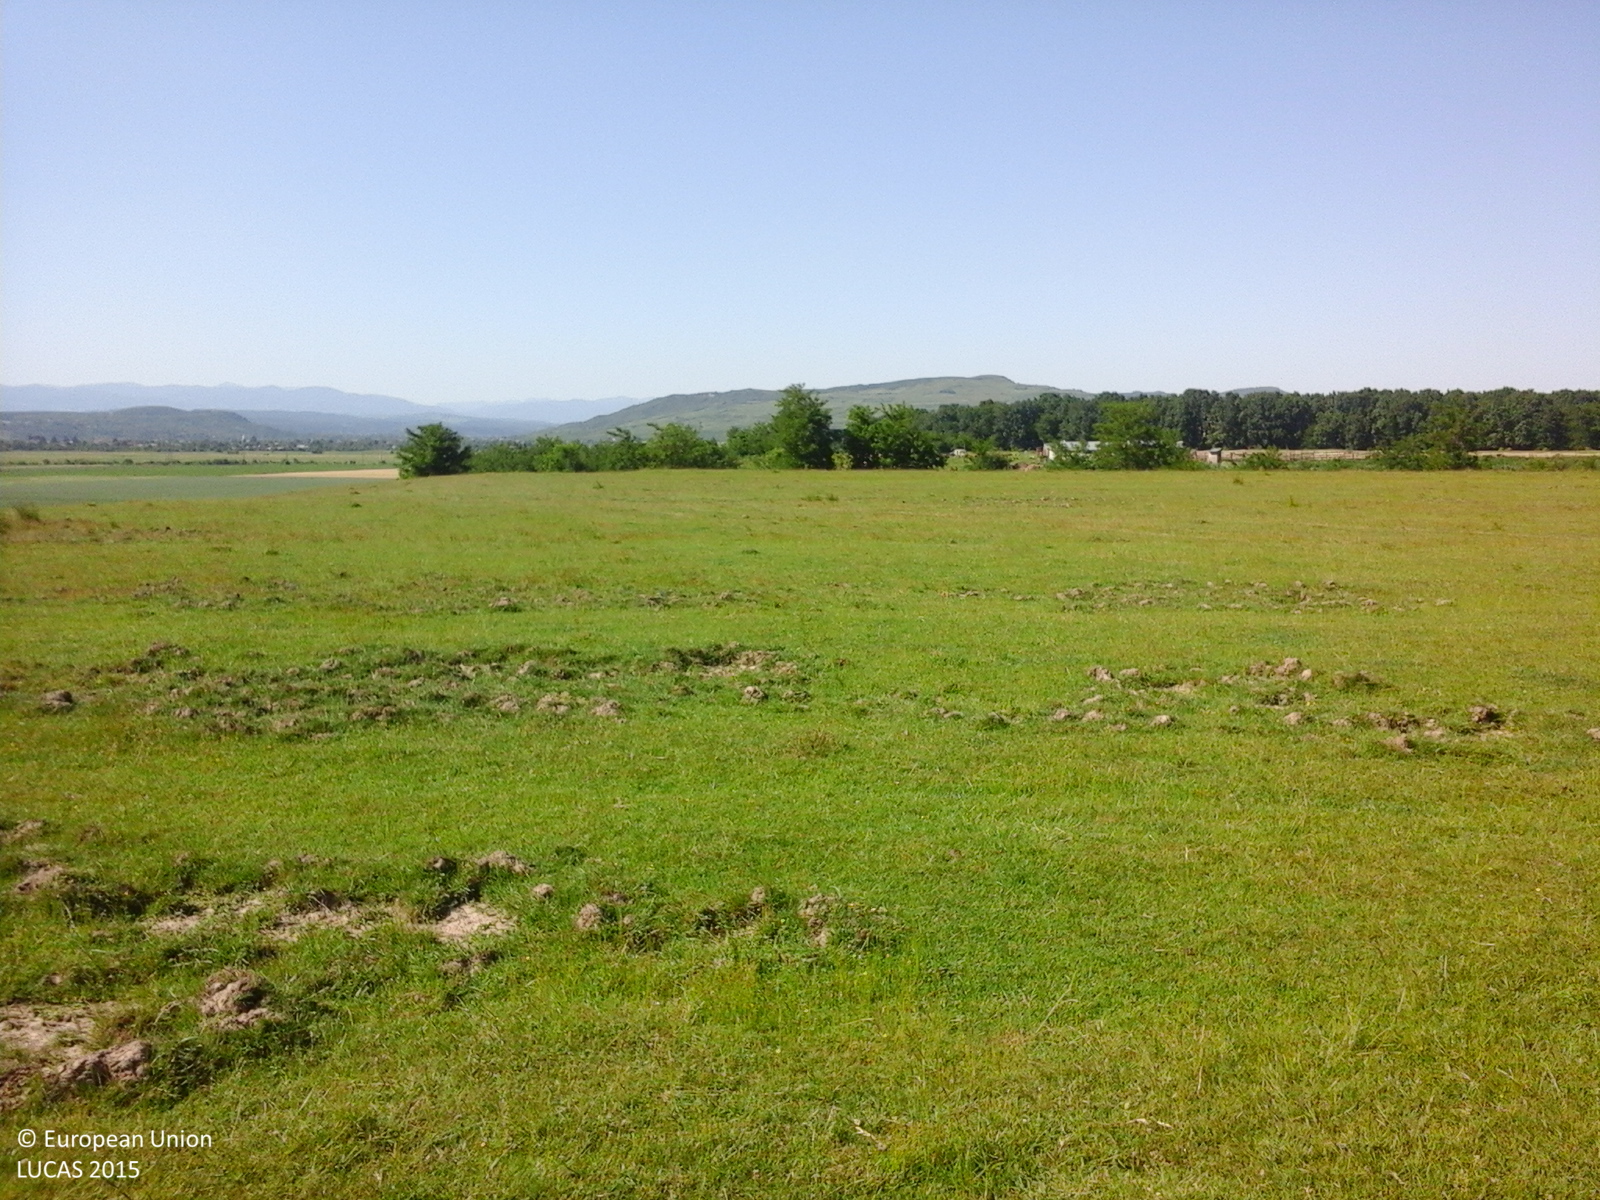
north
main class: Grassland
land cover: Grassland without tree/shrub cover
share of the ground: > 75 %
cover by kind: herbaceous plants 100 %
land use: Agriculture (excluding fallow land and kitchen gardens)
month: June
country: RO
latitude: 45.0739
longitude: 26.0514
